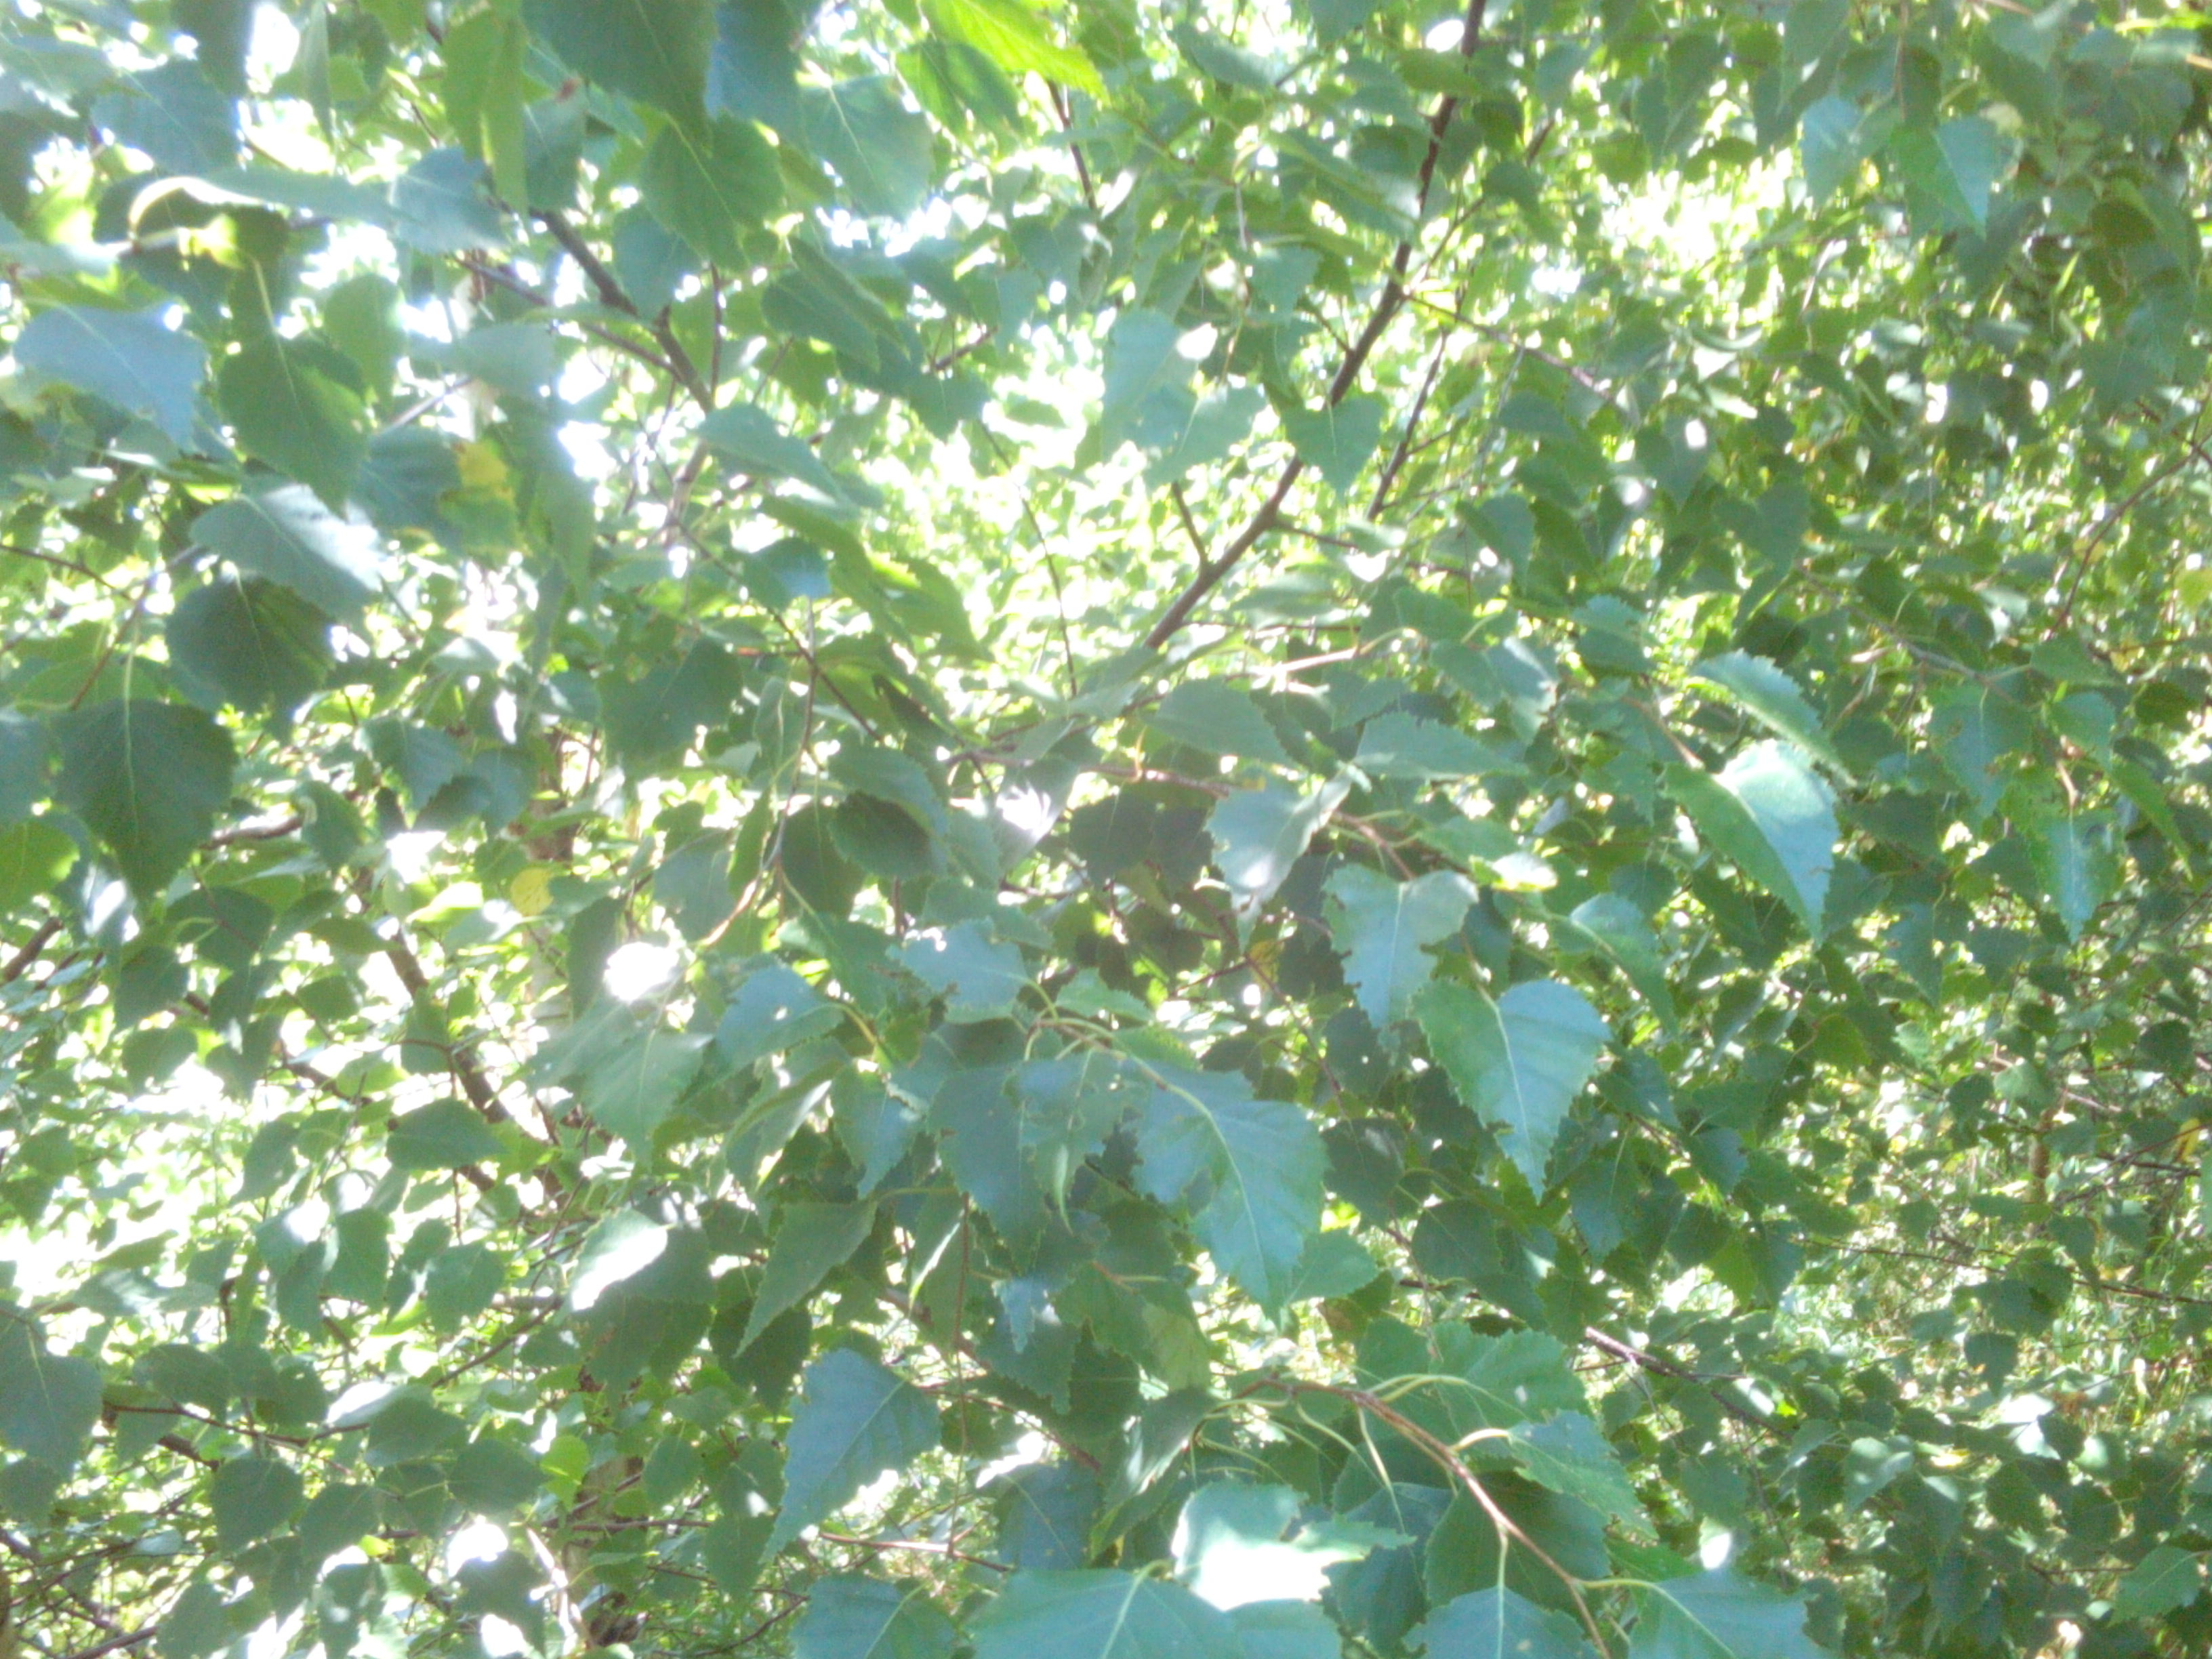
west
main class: Woodland
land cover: Broadleaved woodland
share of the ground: 25 - 50 %
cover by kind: herbaceous plants 75 %, broadleaved forest trees 25 %
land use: Semi-natural and natural areas not in use
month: August
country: LV
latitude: 56.9039
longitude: 21.9185
